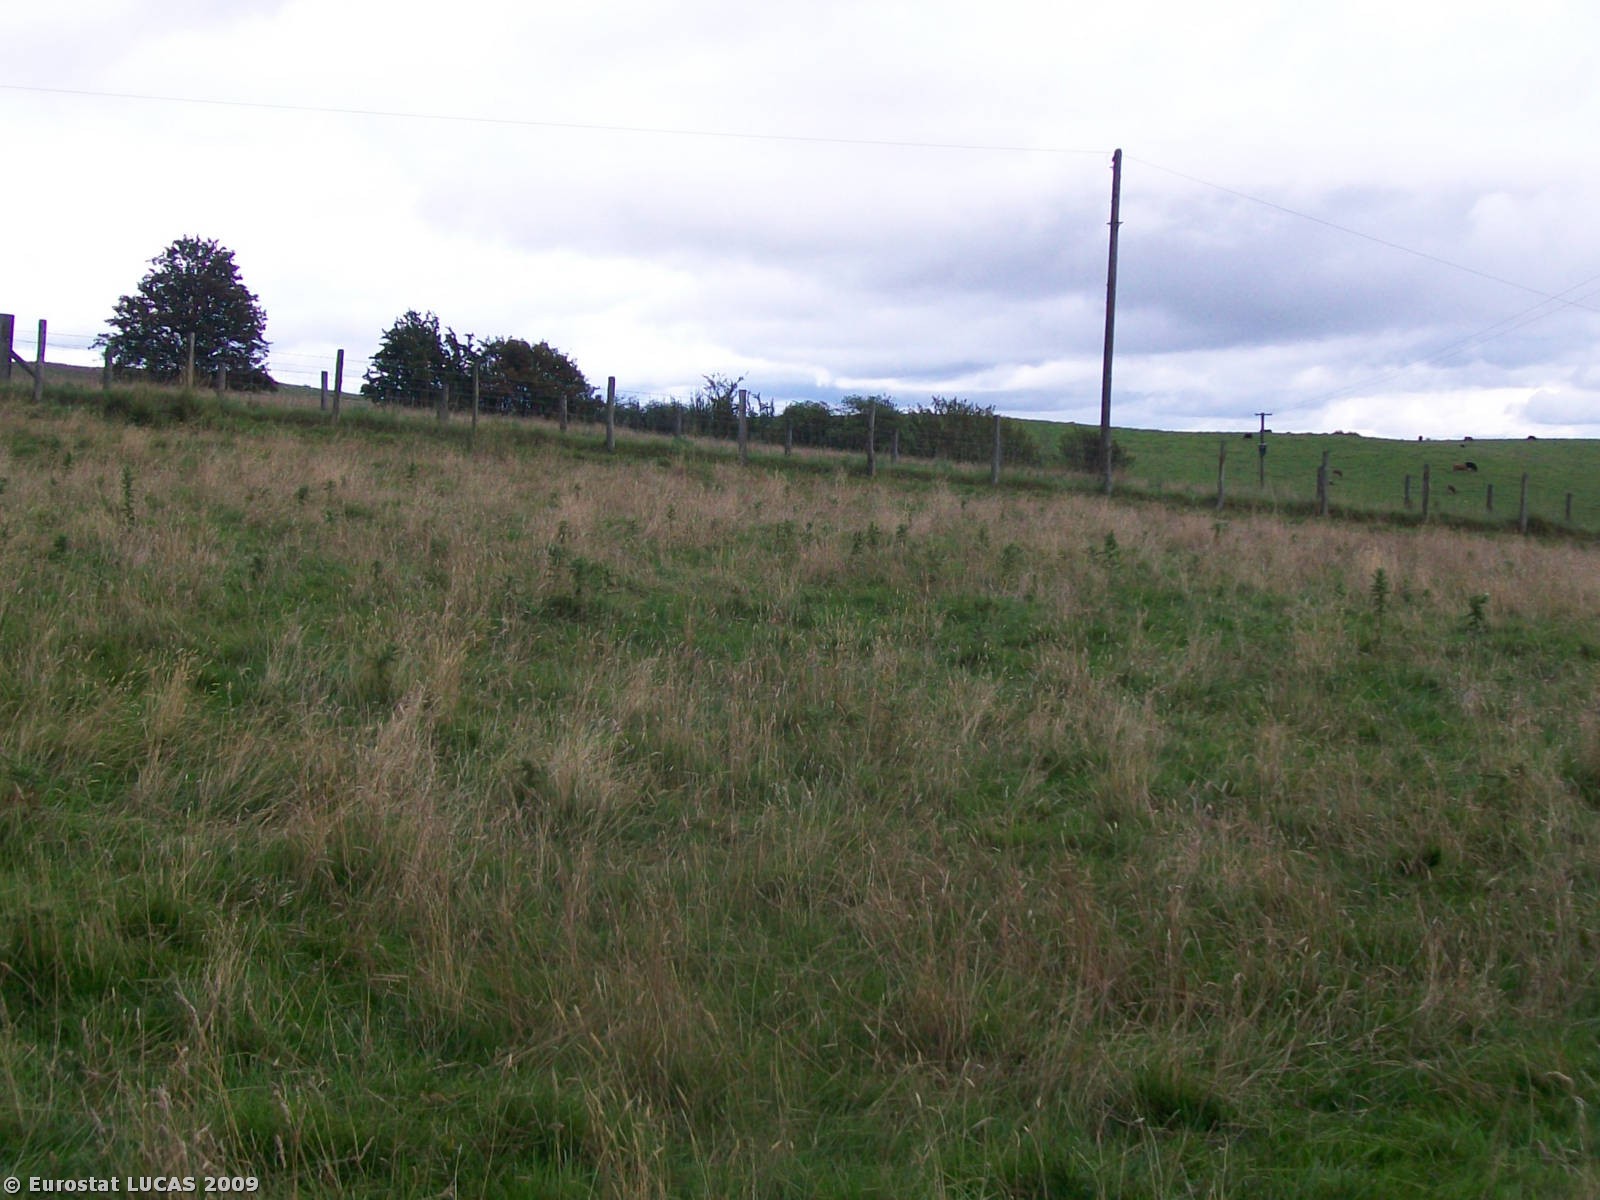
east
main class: Grassland
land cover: Grassland without tree/shrub cover
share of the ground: > 75 %
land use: Agriculture (excluding fallow land and kitchen gardens)
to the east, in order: Grassland without tree/shrub cover; Fences; Grass margins; Tracks; Grass margins; Fences; Grassland without tree/shrub cover; Fences; Managed hedges; Artificial constructions in urban areas; Fences; Abandoned hedges; Grassland without tree/shrub cover
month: August
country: GB
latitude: 52.7616
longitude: -3.4047
